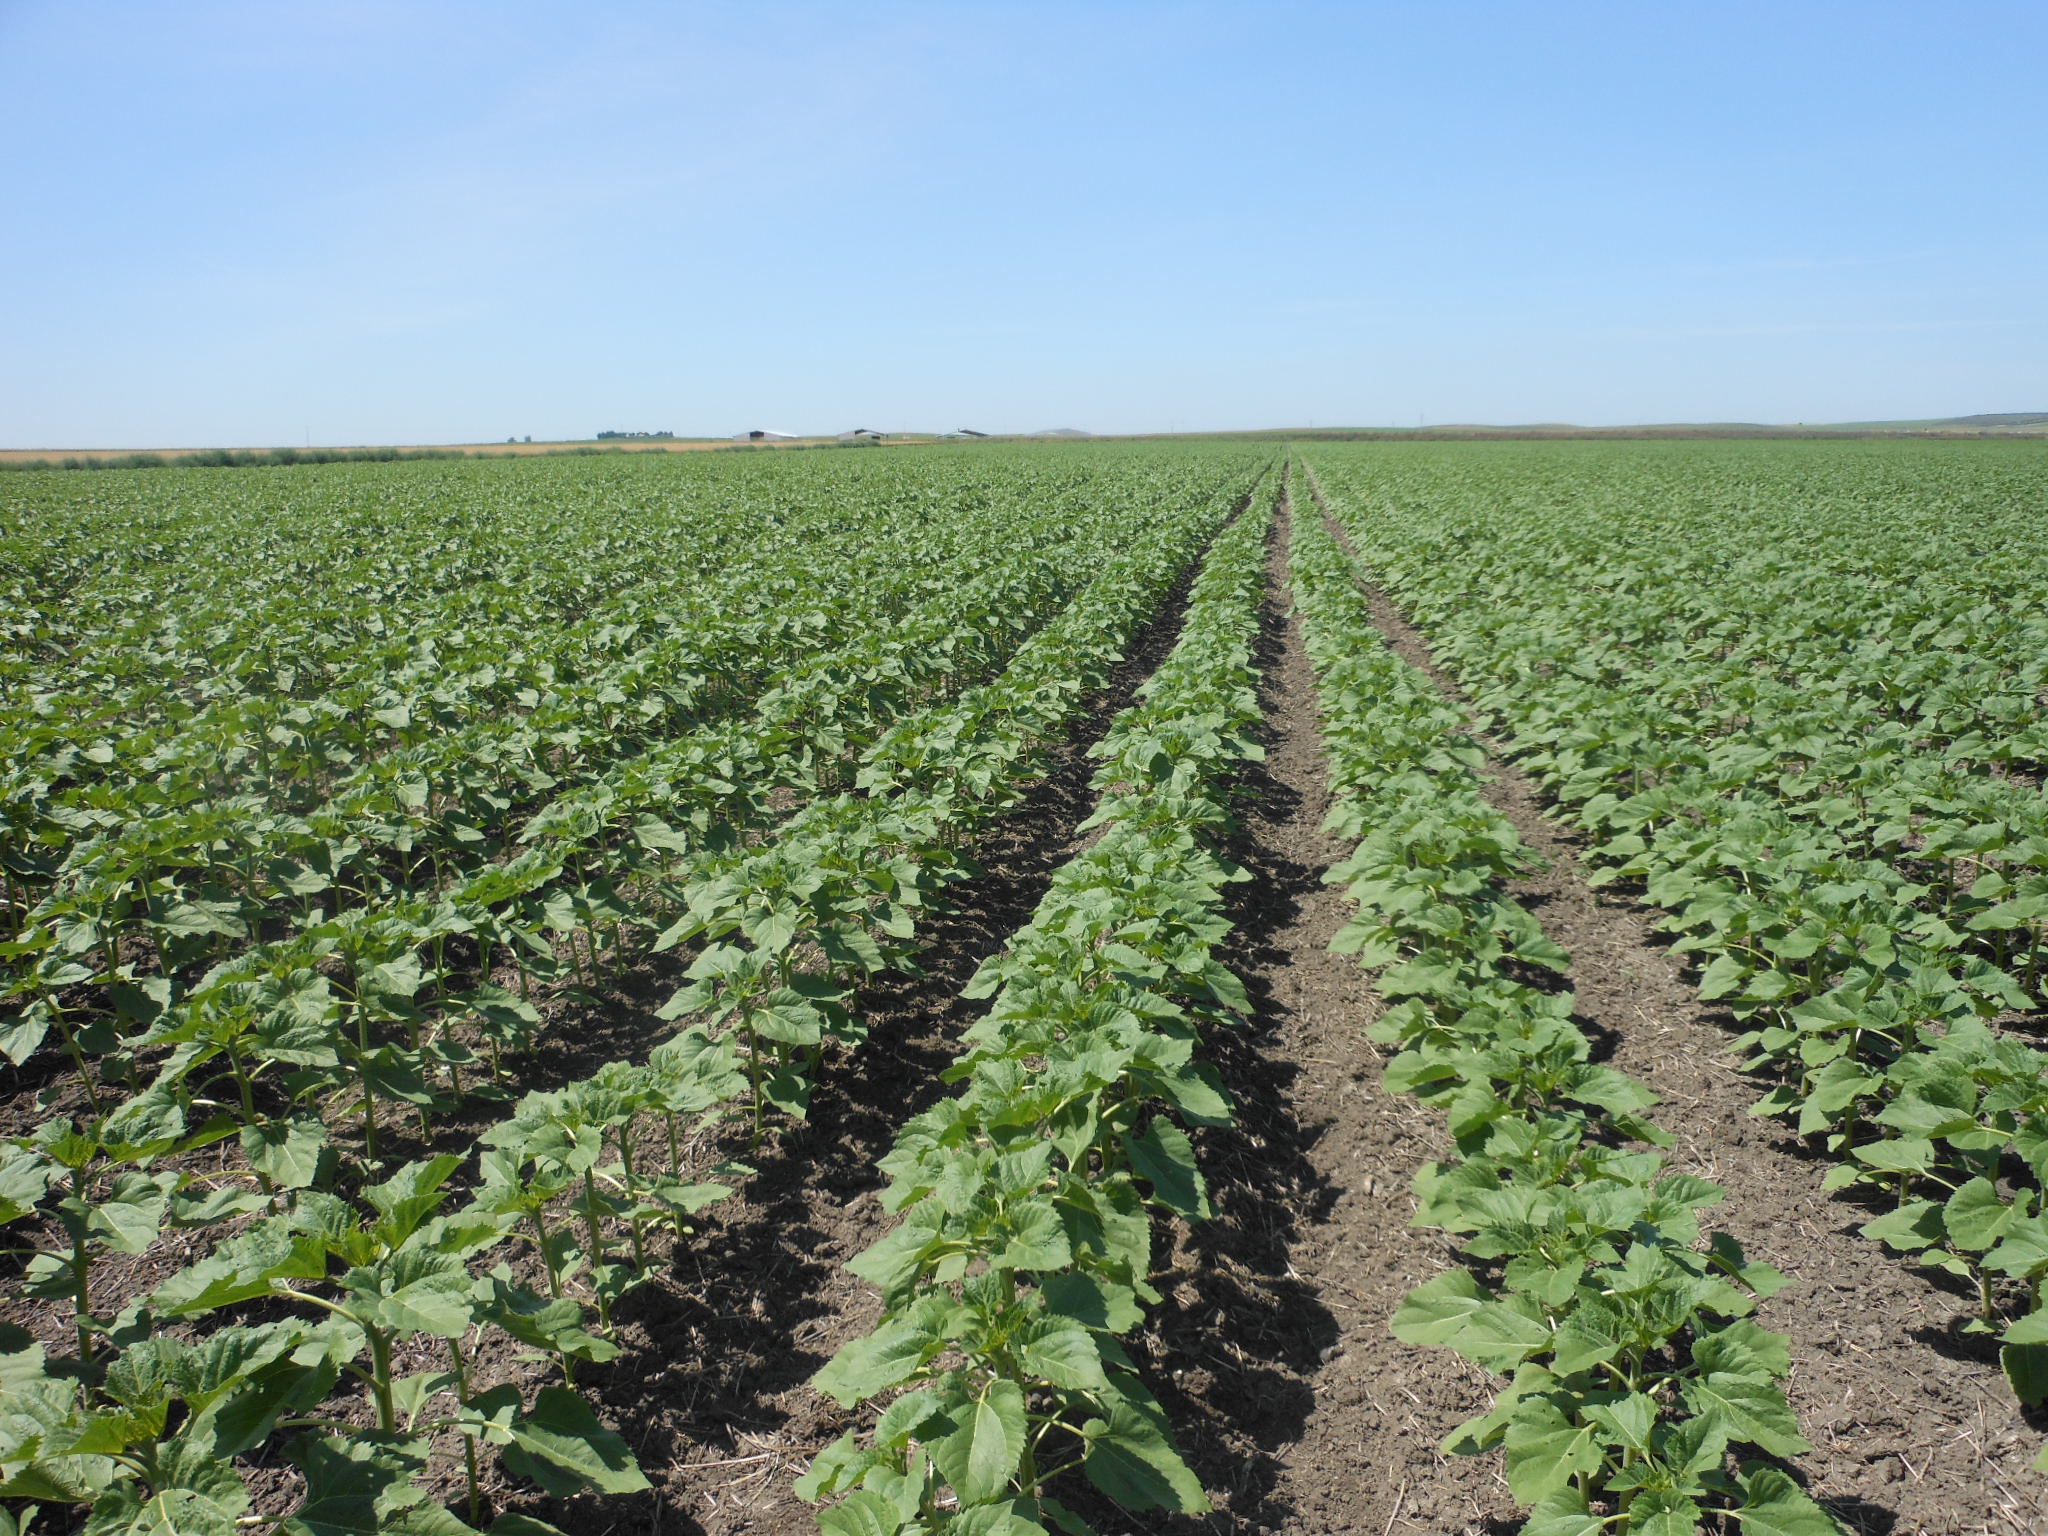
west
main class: Cropland
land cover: Sunflower
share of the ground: 25 - 50 %
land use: Agriculture (excluding fallow land and kitchen gardens)
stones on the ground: < 10 %
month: April
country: ES
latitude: 37.3892
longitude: -5.5012
